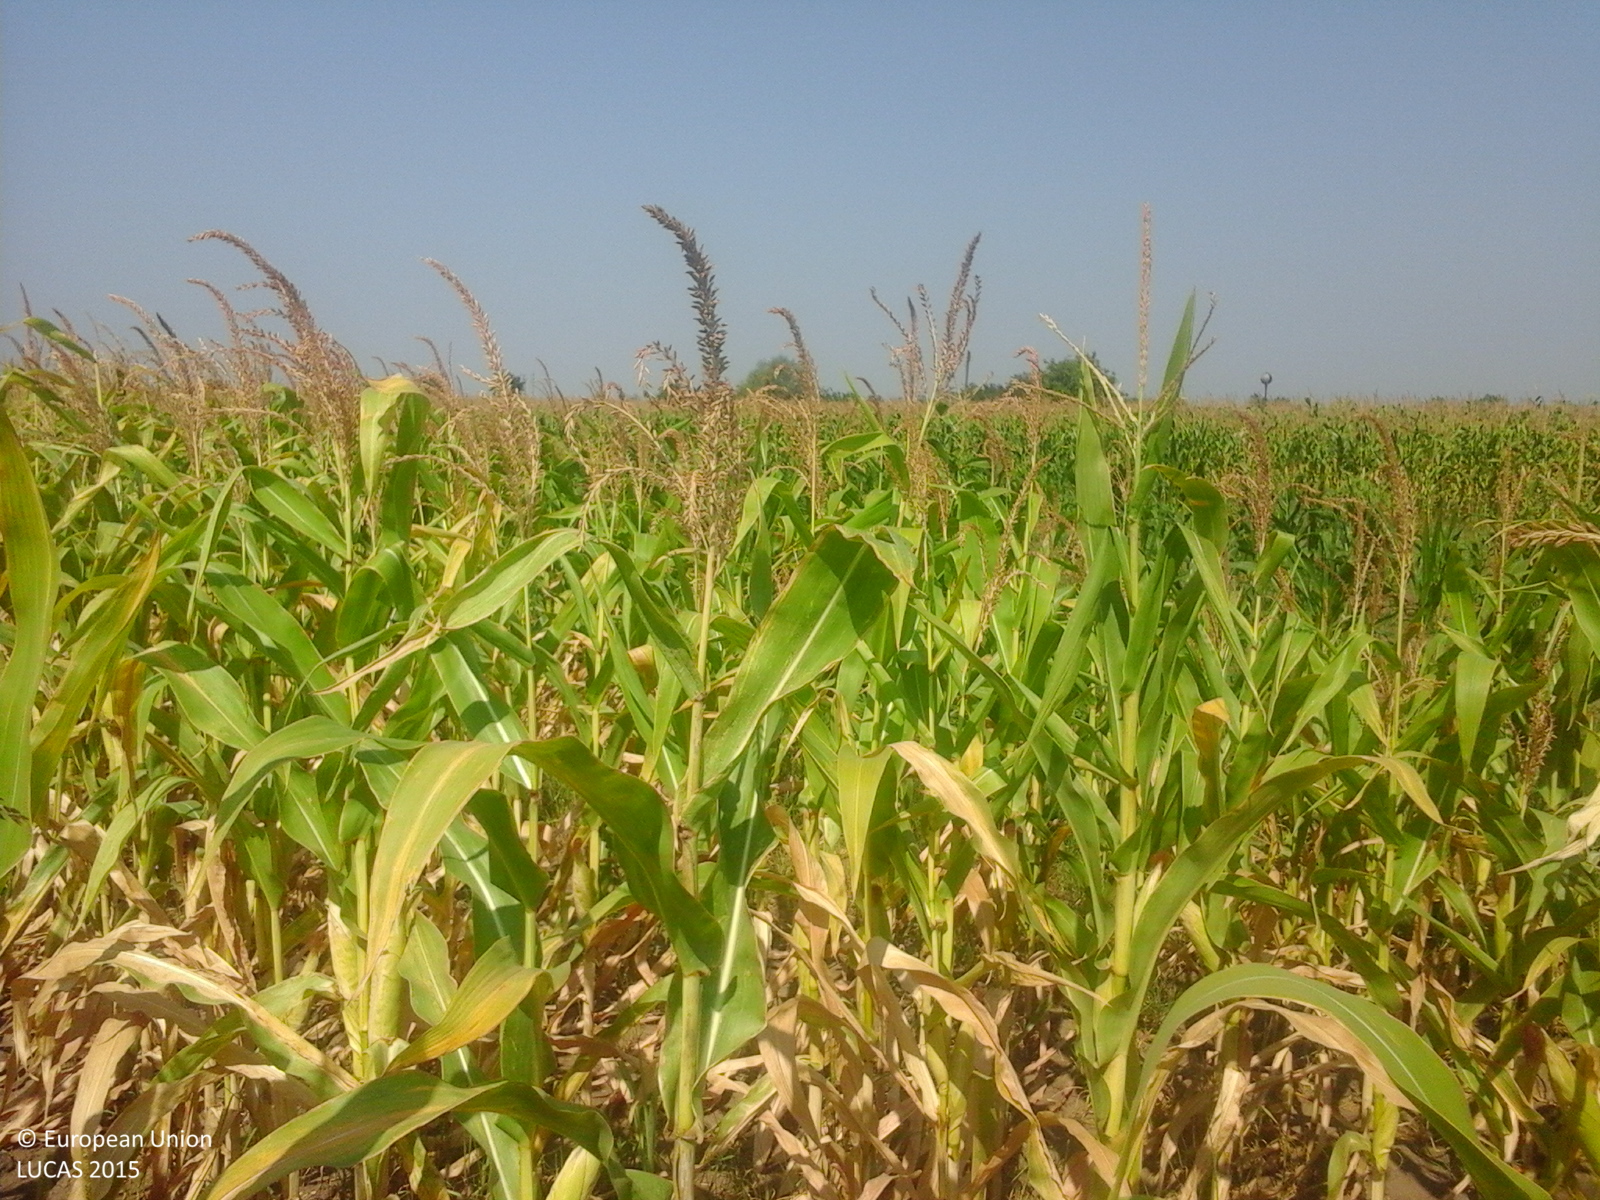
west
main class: Cropland
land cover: Maize
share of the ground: > 75 %
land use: Agriculture (excluding fallow land and kitchen gardens)
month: August
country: RO
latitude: 45.7420
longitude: 27.4942
